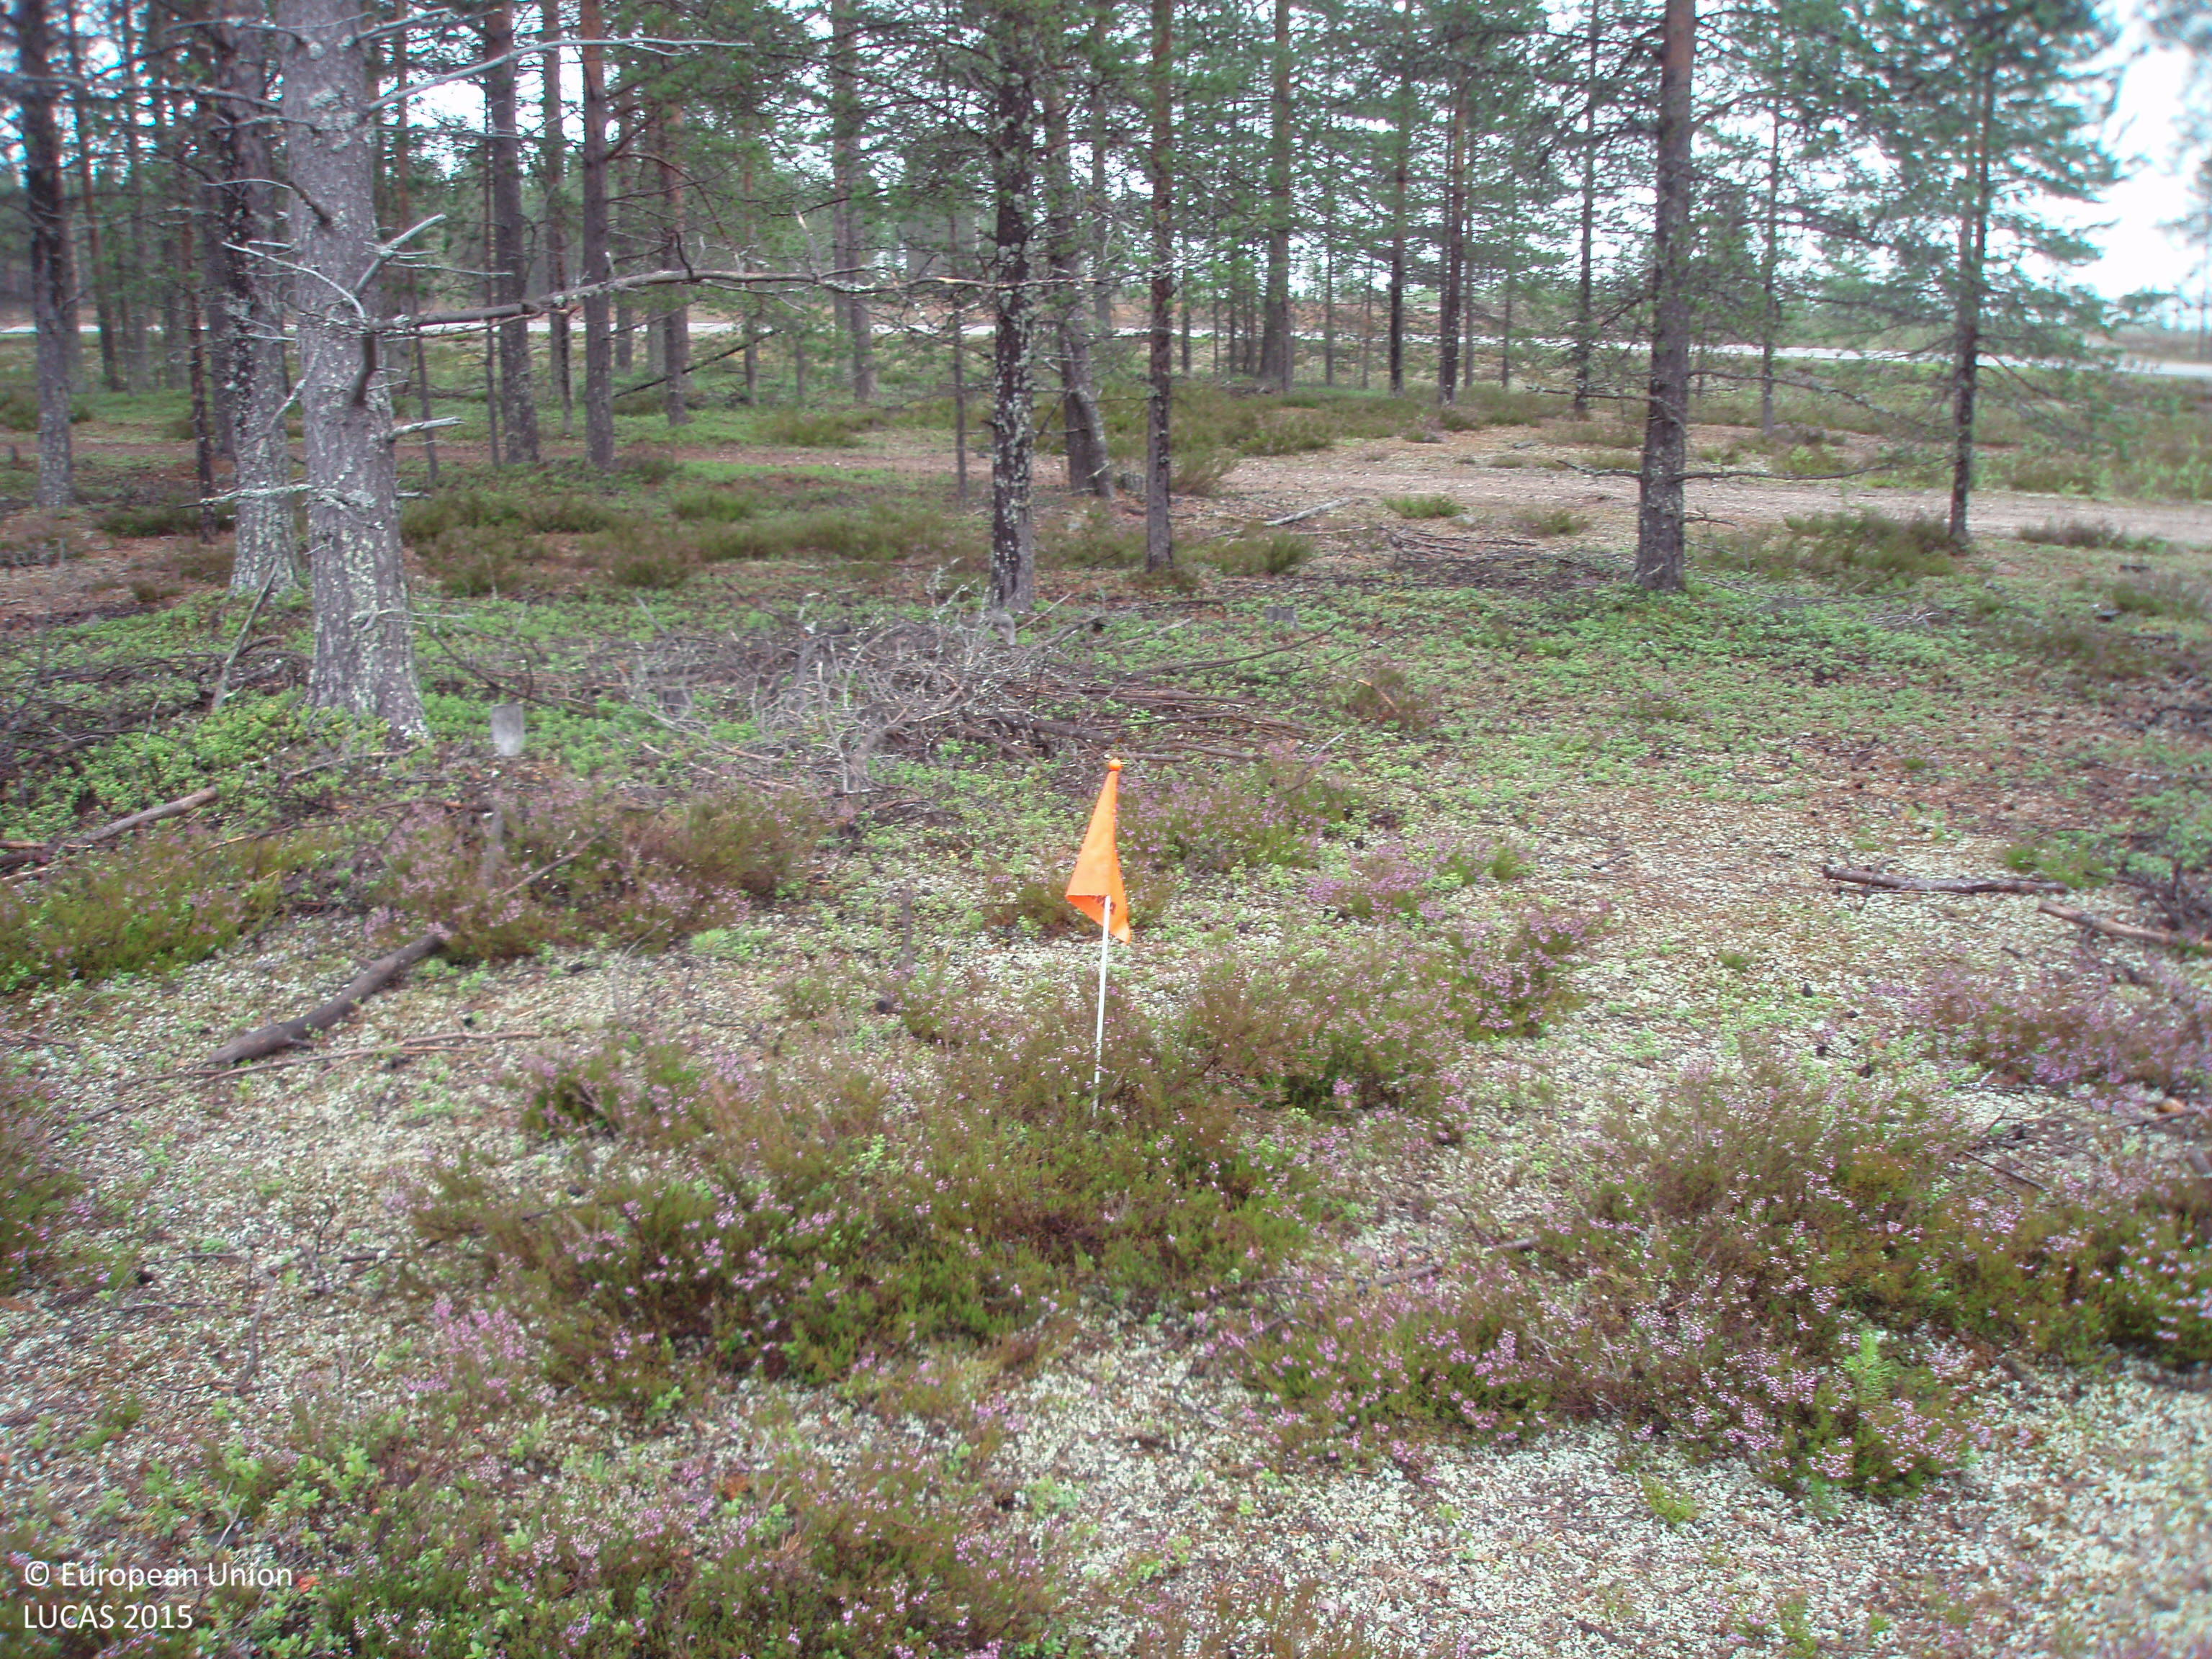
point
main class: Woodland
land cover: Pine dominated coniferous woodland
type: boreal forest
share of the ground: > 75 %
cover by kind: coniferous forest trees 75 %, shrubs 25 %
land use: Forestry
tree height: > 5 m
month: August
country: FI
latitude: 65.6625
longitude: 27.3679
